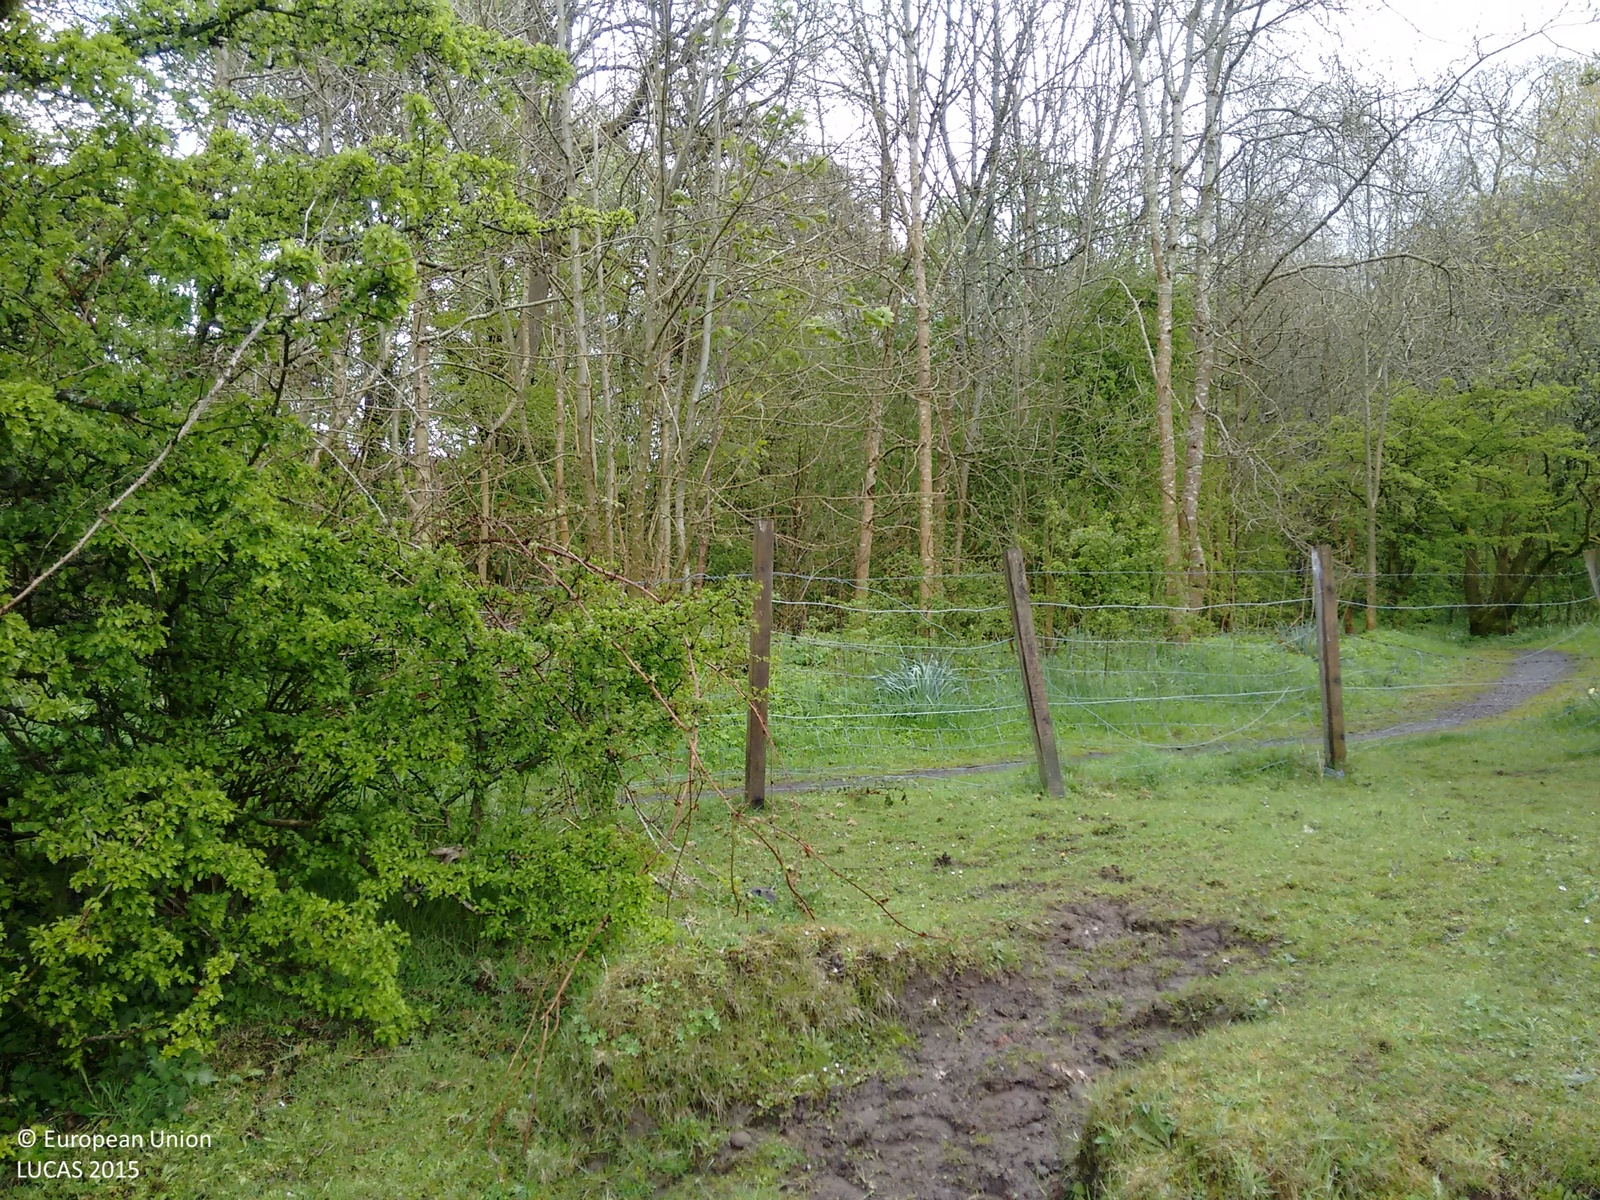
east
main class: Grassland
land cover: Grassland with sparse tree/shrub cover
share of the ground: > 75 %
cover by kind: herbaceous plants 90 %, broadleaved forest trees 5 %, shrubs 5 %
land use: Agriculture (excluding fallow land and kitchen gardens)
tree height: < 5 m
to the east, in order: Grassland with sparse tree/shrub cover; Rivers and streams; Grass margins; Artificial constructions in urban areas
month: May
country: GB
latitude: 55.9835
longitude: -4.3108
